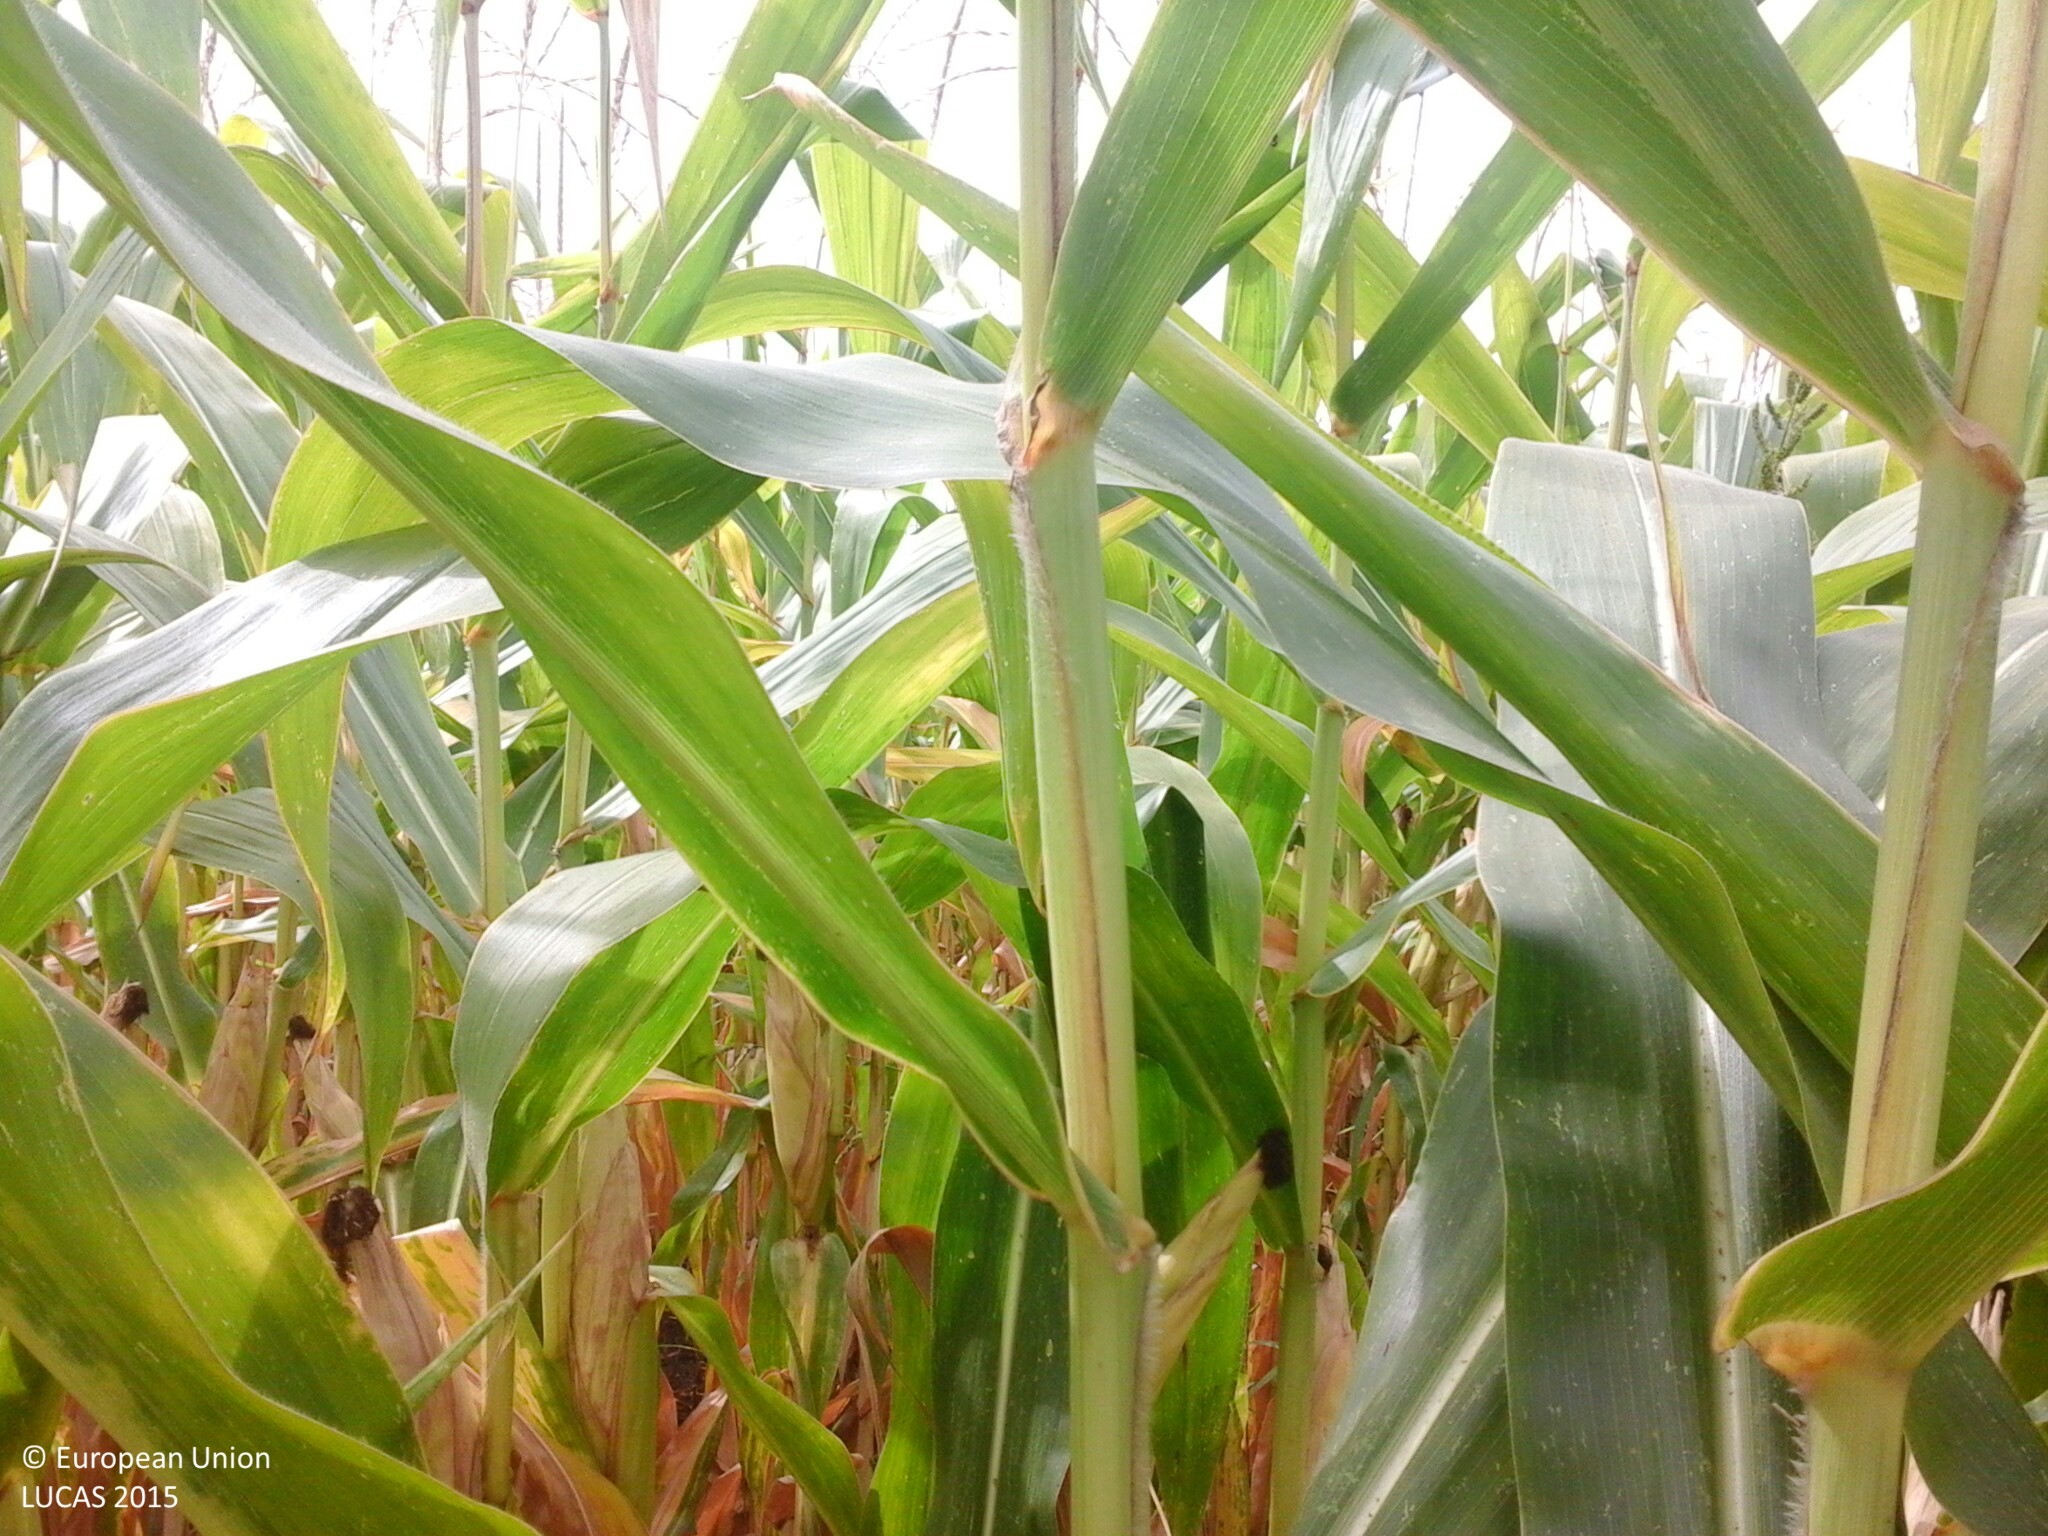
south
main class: Cropland
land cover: Maize
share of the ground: > 75 %
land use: Agriculture (excluding fallow land and kitchen gardens)
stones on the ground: < 10 %
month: August
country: HU
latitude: 46.9814
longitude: 21.5175
